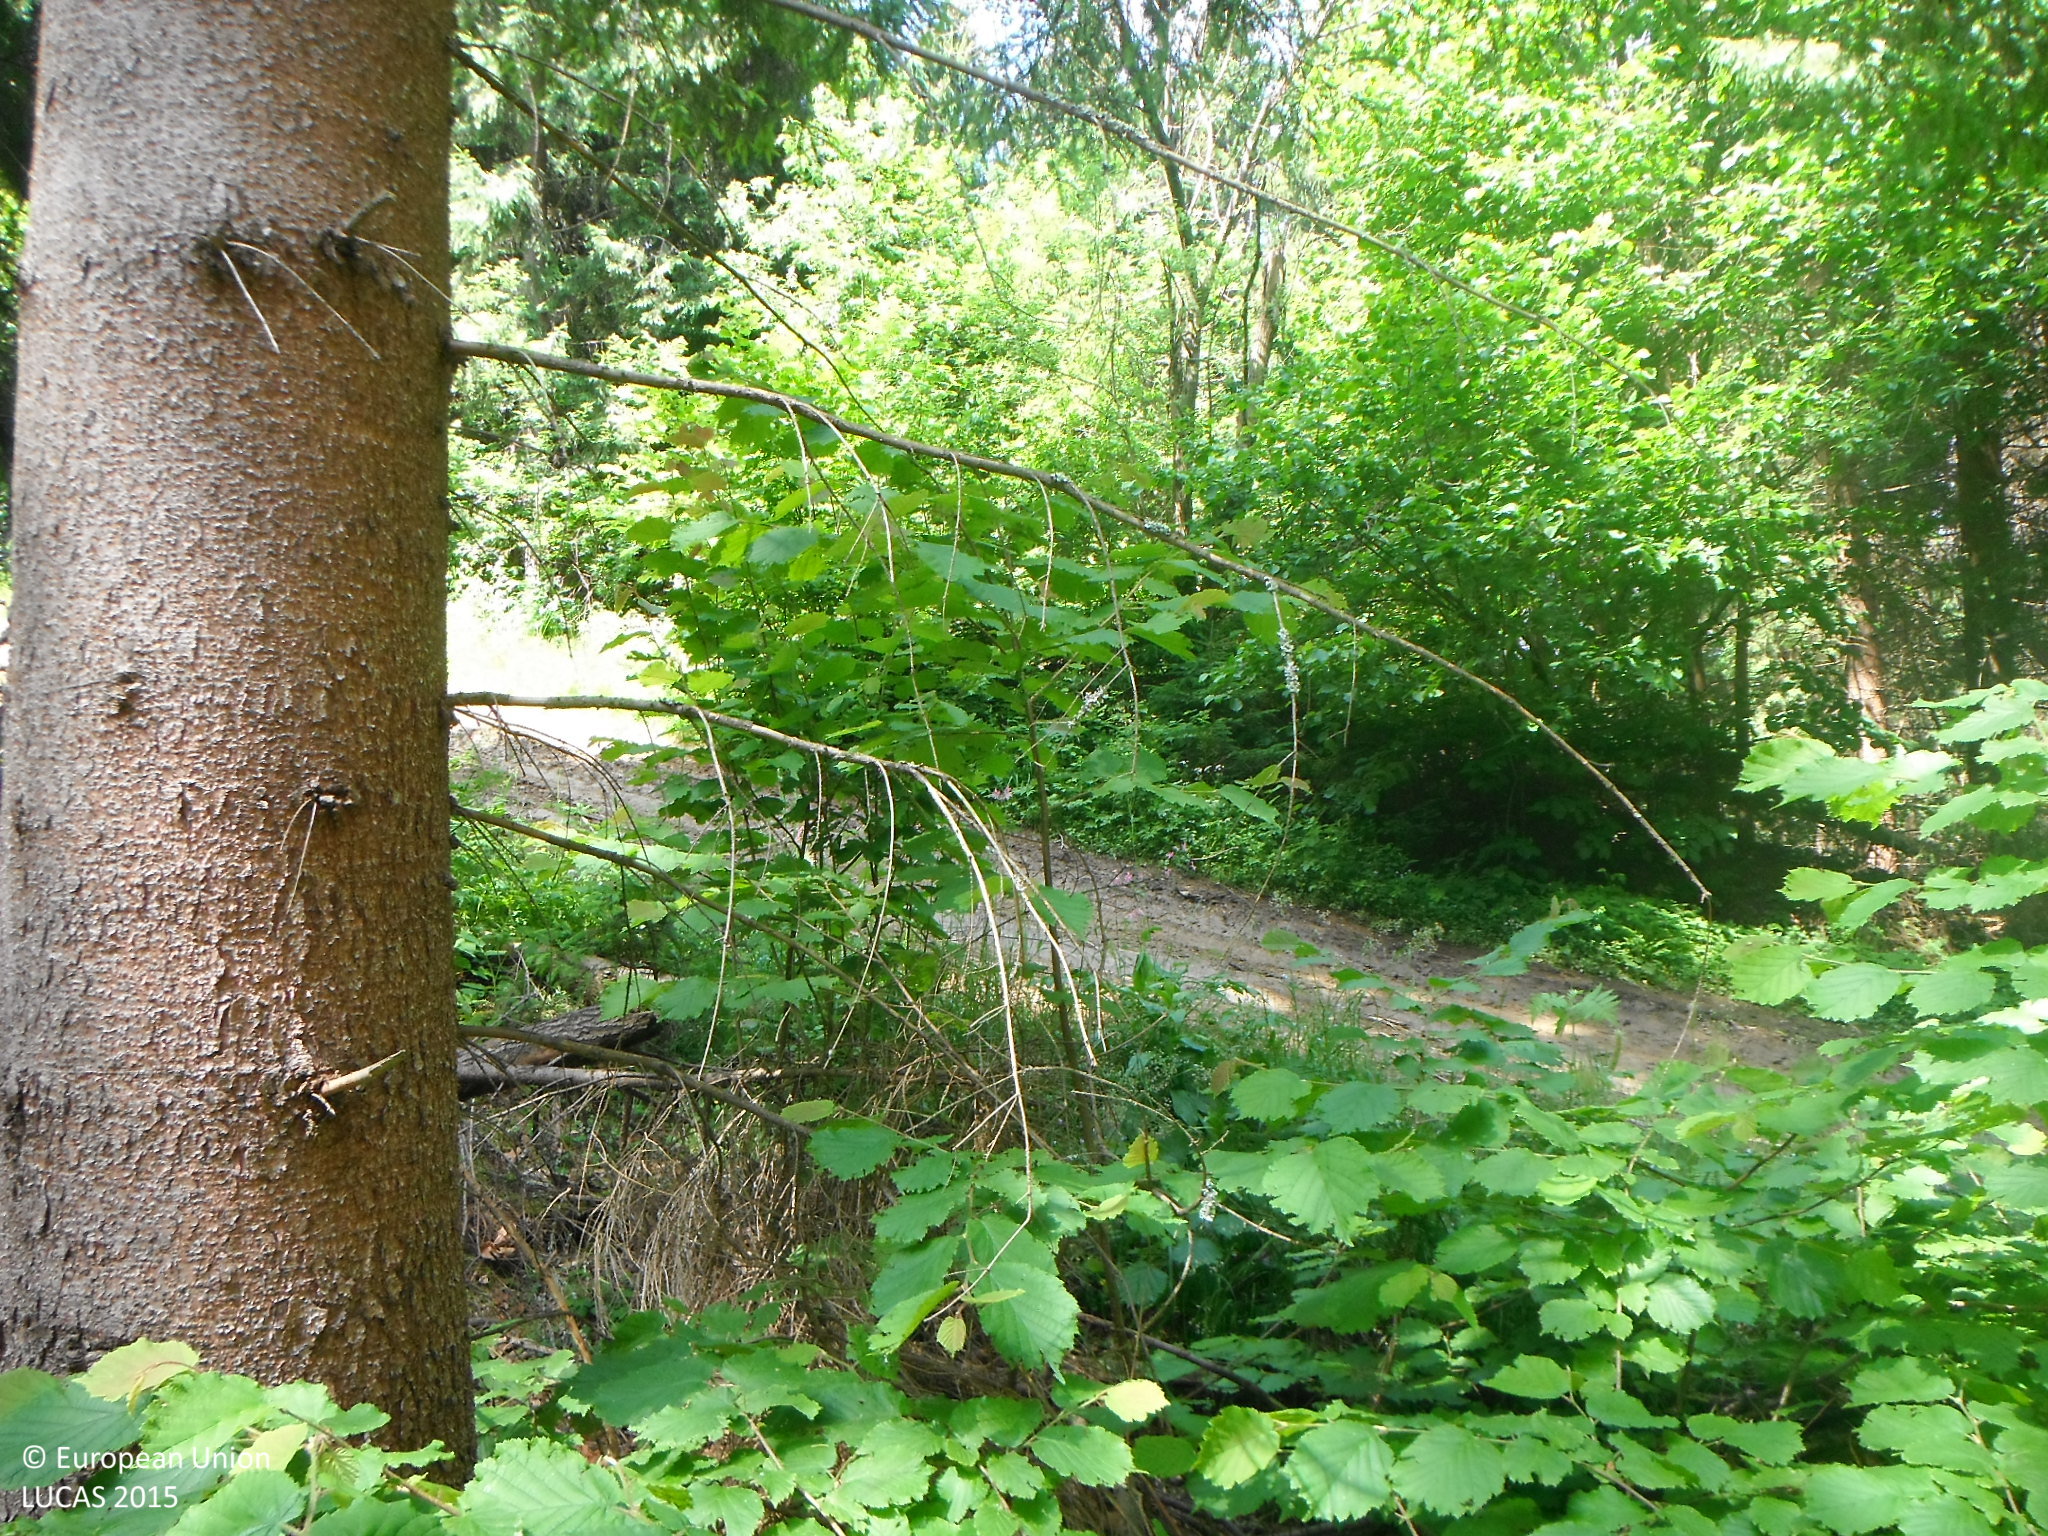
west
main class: Woodland
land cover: Spruce dominated mixed woodland
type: hemiboreal forest and nemoral coniferous forest and mixed broadleaved-coniferous forest
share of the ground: > 75 %
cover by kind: coniferous forest trees 65 %, broadleaved forest trees 25 %, herbaceous plants 10 %
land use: Forestry
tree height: > 5 m
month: June
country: SK
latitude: 49.2621
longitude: 19.4940
